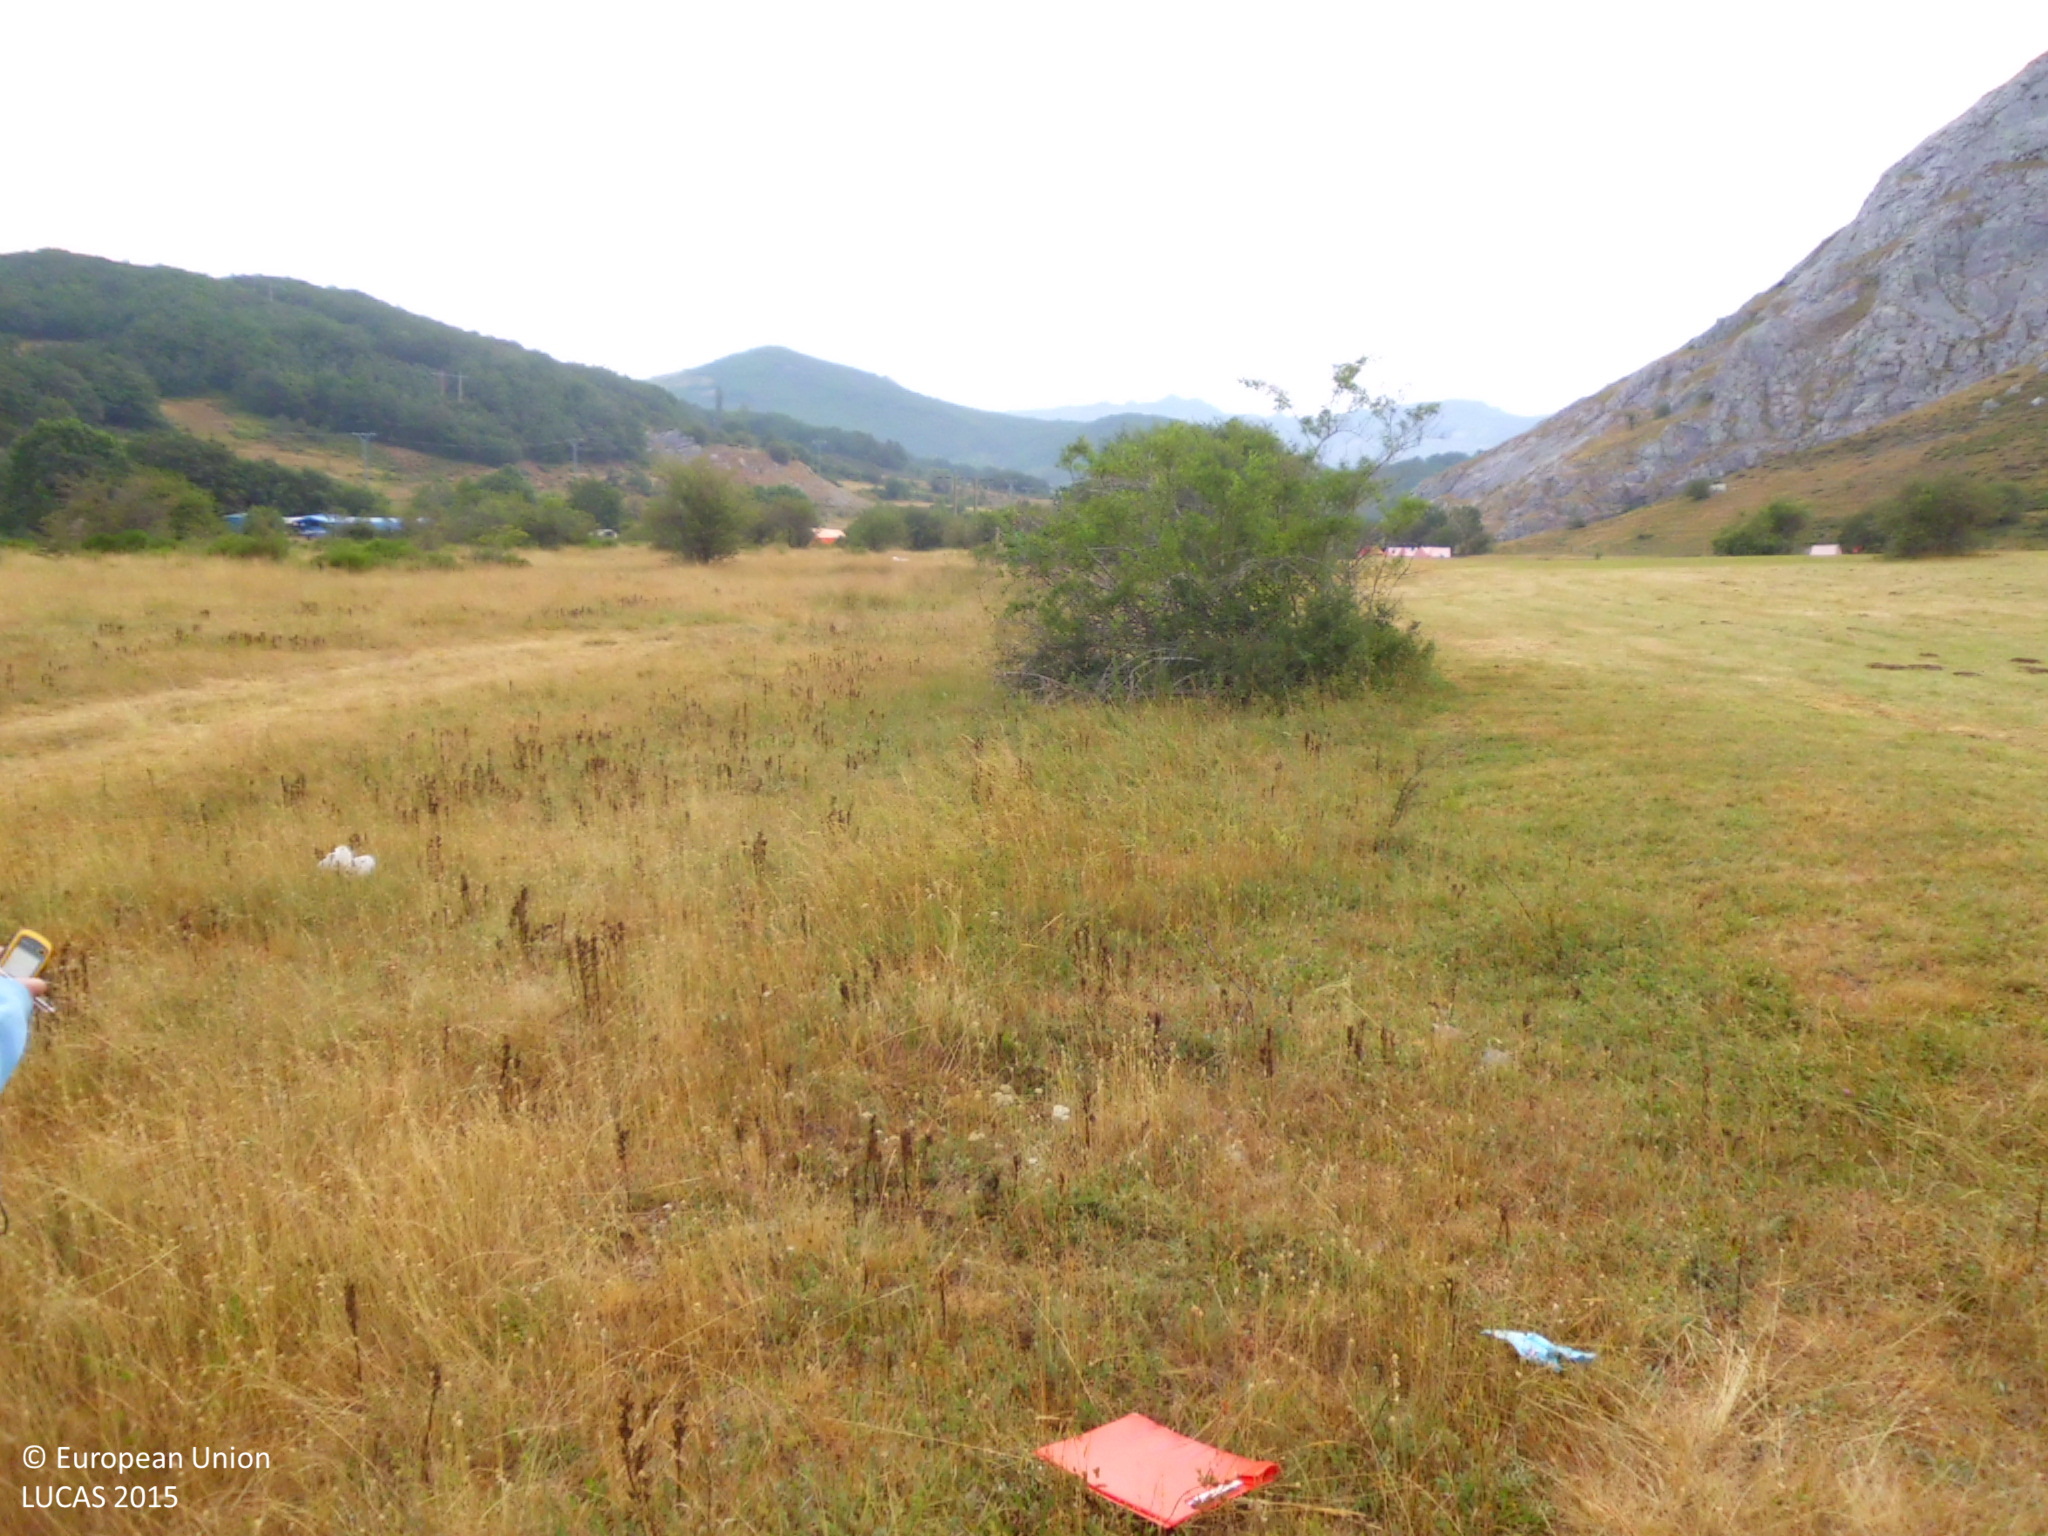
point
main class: Grassland
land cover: Grassland without tree/shrub cover
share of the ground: > 75 %
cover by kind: herbaceous plants 100 %
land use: Agriculture (excluding fallow land and kitchen gardens)
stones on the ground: 25 - 50 %
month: July
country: ES
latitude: 42.9795
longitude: -4.4892
